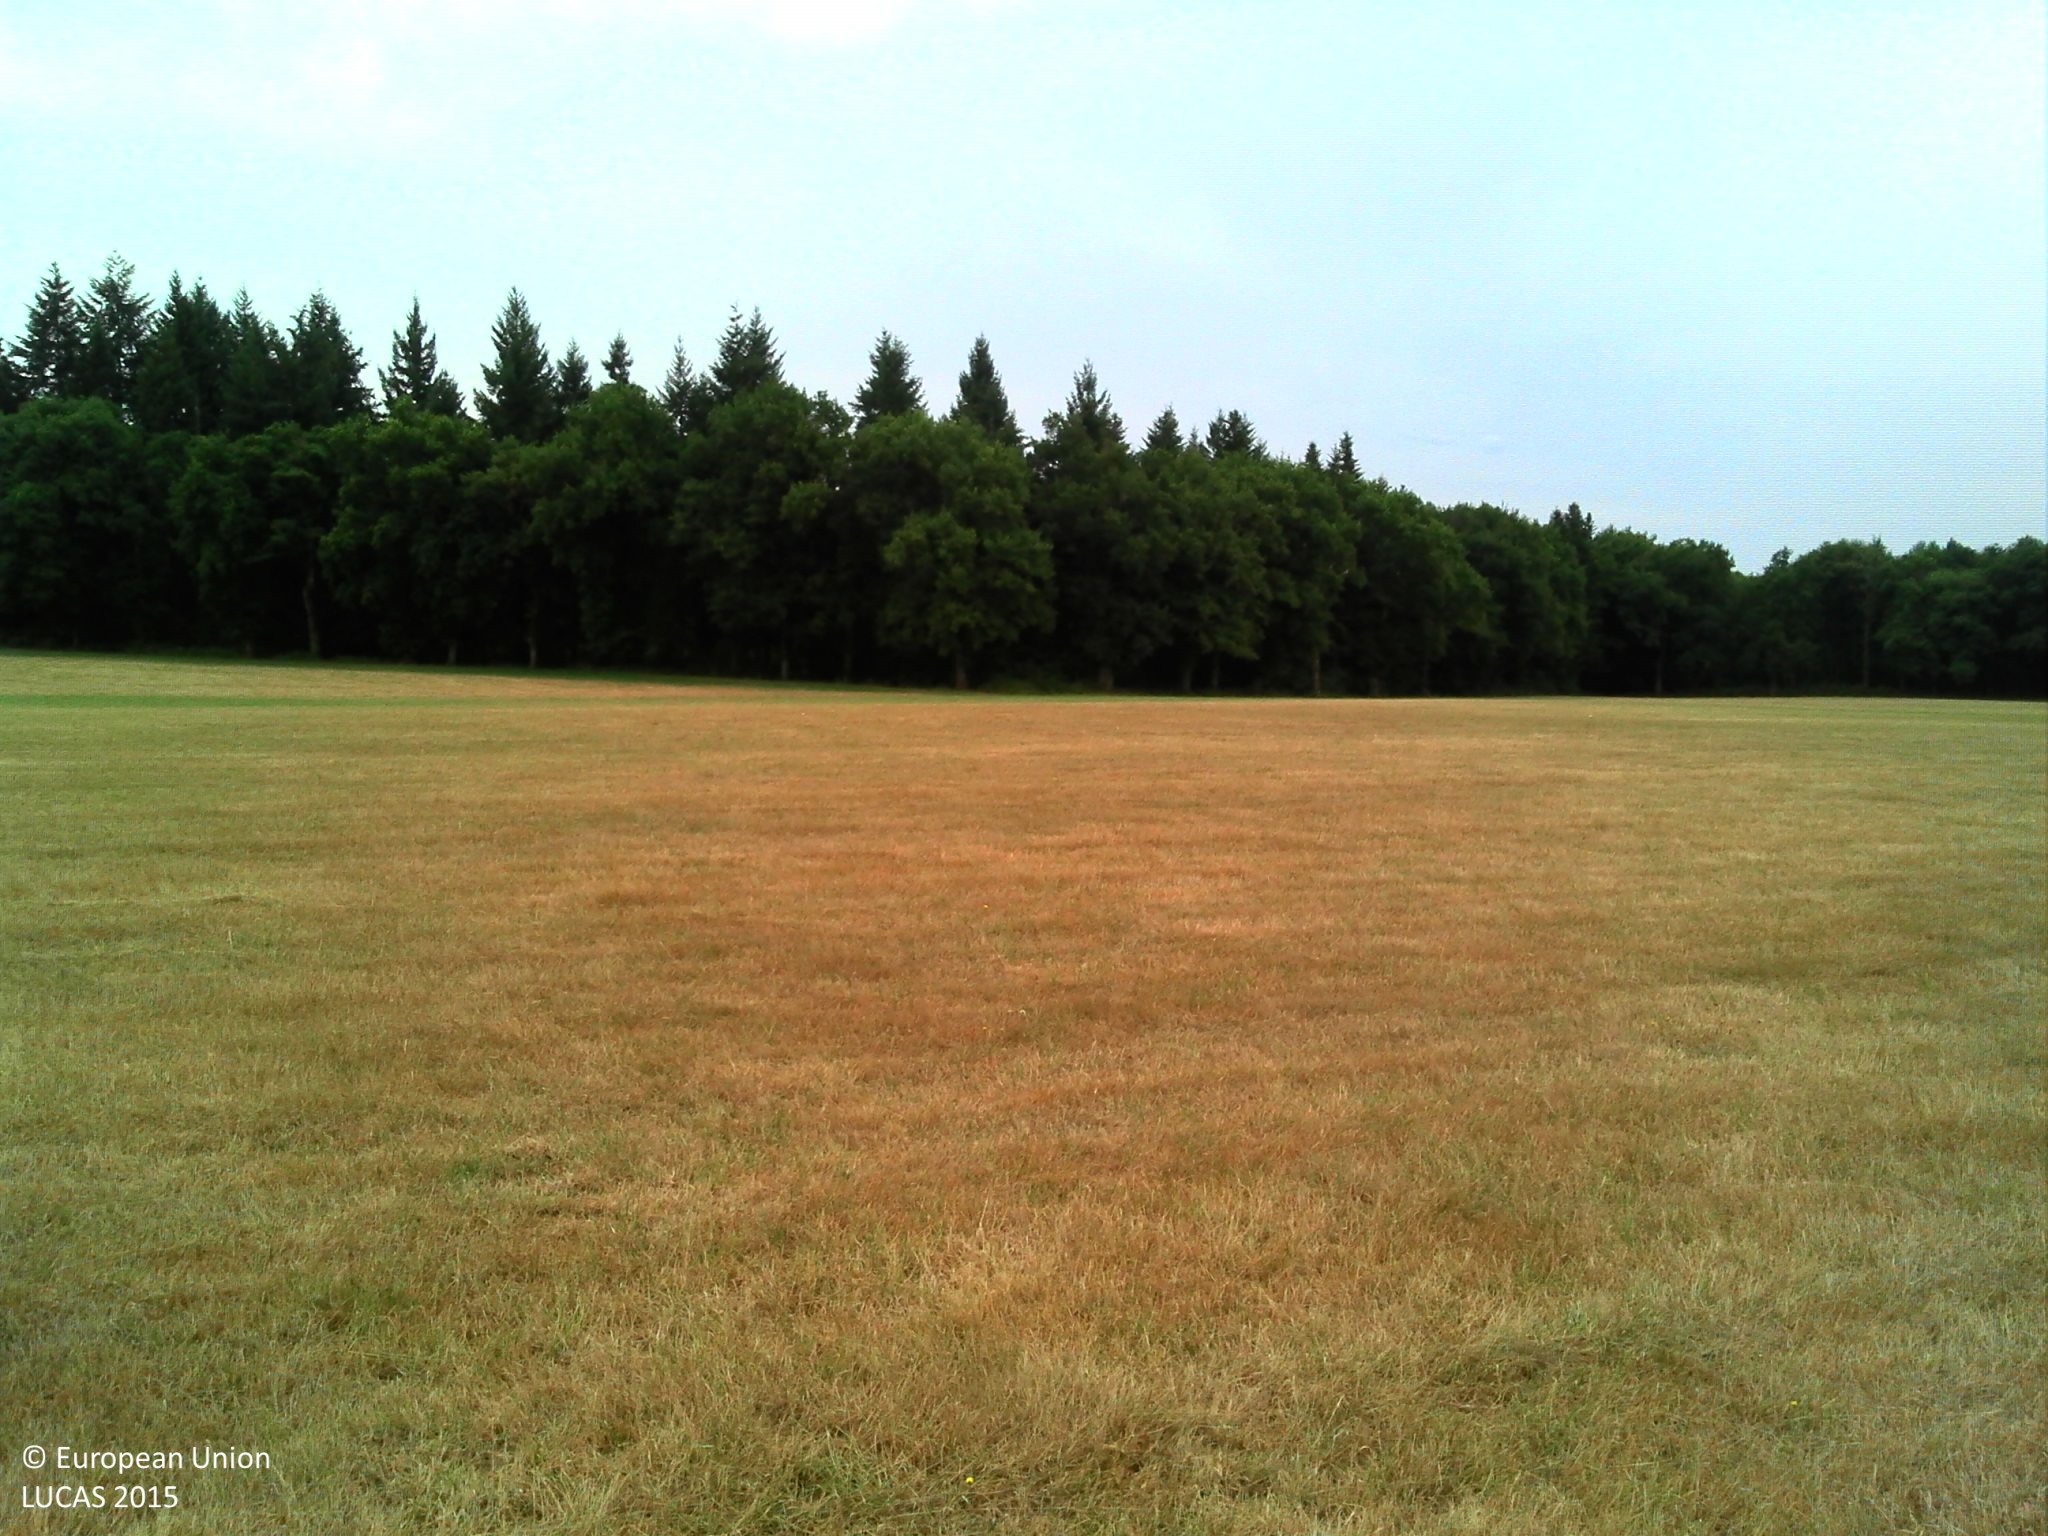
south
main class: Grassland
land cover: Grassland without tree/shrub cover
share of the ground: > 75 %
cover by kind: herbaceous plants 100 %
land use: Agriculture (excluding fallow land and kitchen gardens)
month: July
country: FR
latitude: 46.2786
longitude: 0.9936
